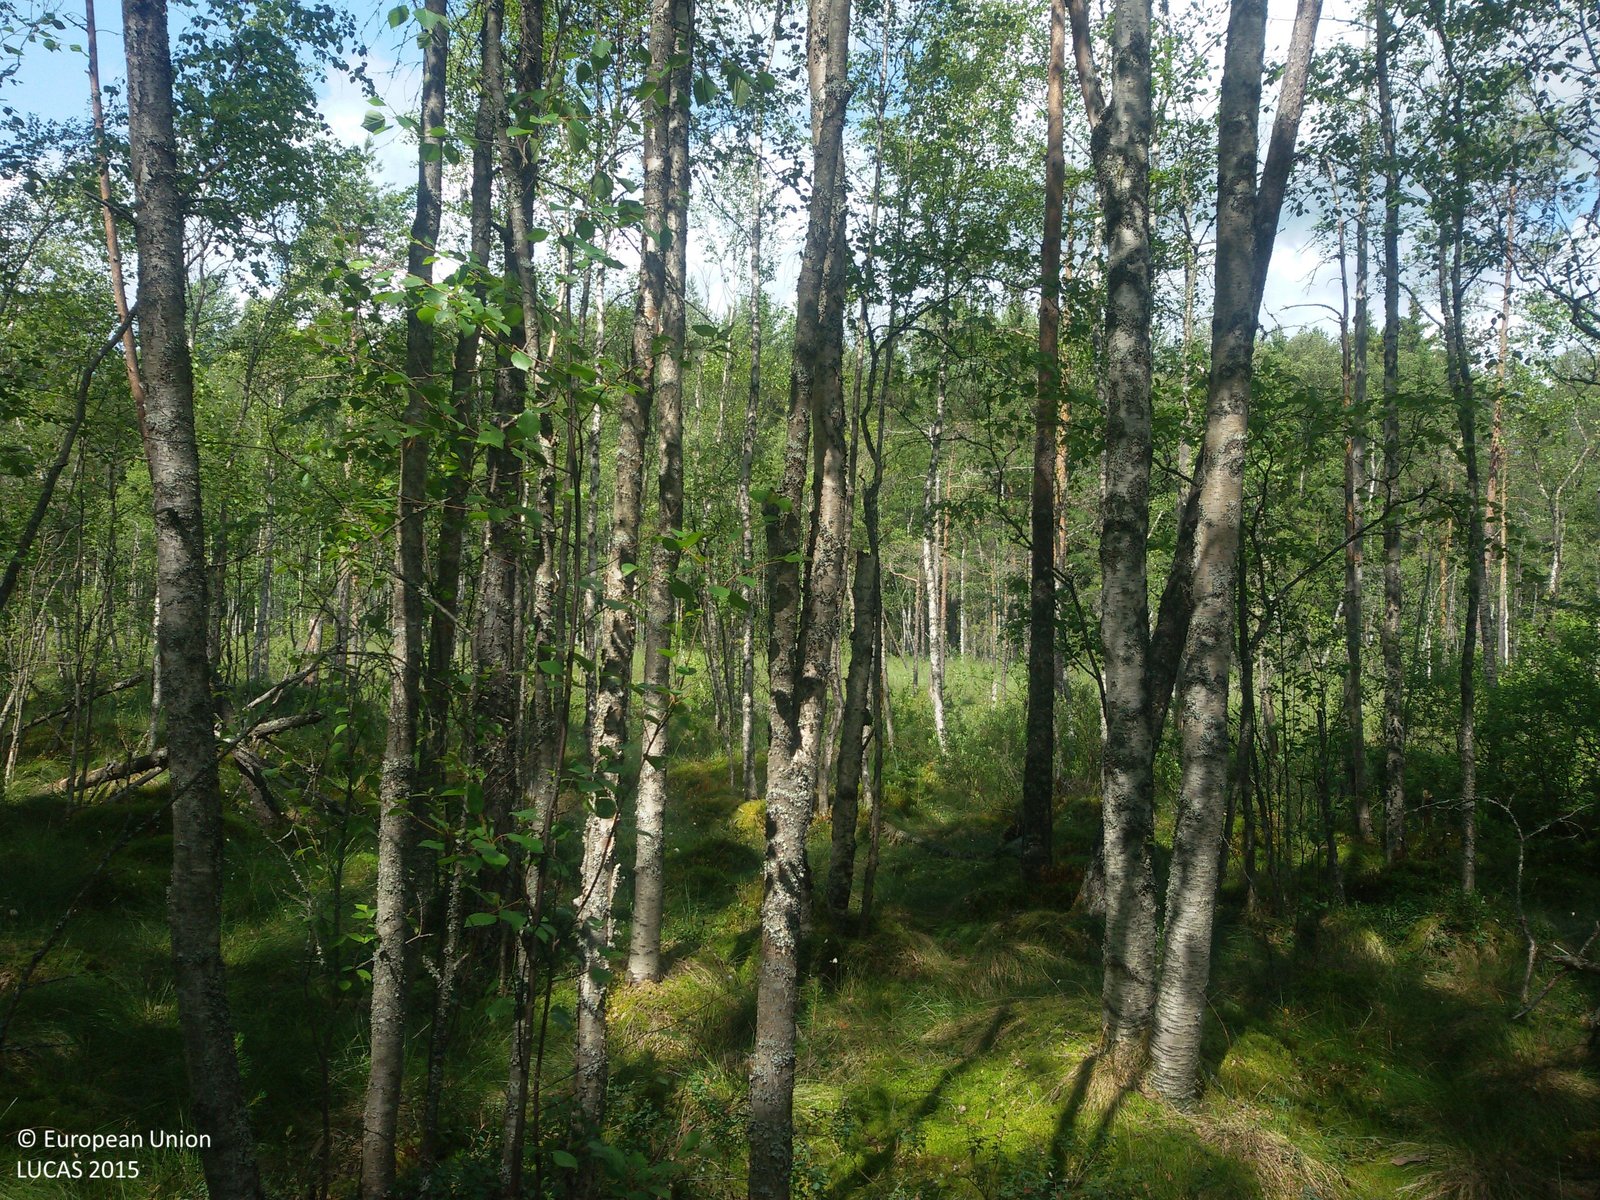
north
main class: Woodland
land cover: Broadleaved woodland
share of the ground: > 75 %
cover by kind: broadleaved forest trees 80 %, herbaceous plants 10 %, lichens and mosses 10 %
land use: Semi-natural and natural areas not in use
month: July
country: SE
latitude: 60.5239
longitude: 15.0343
